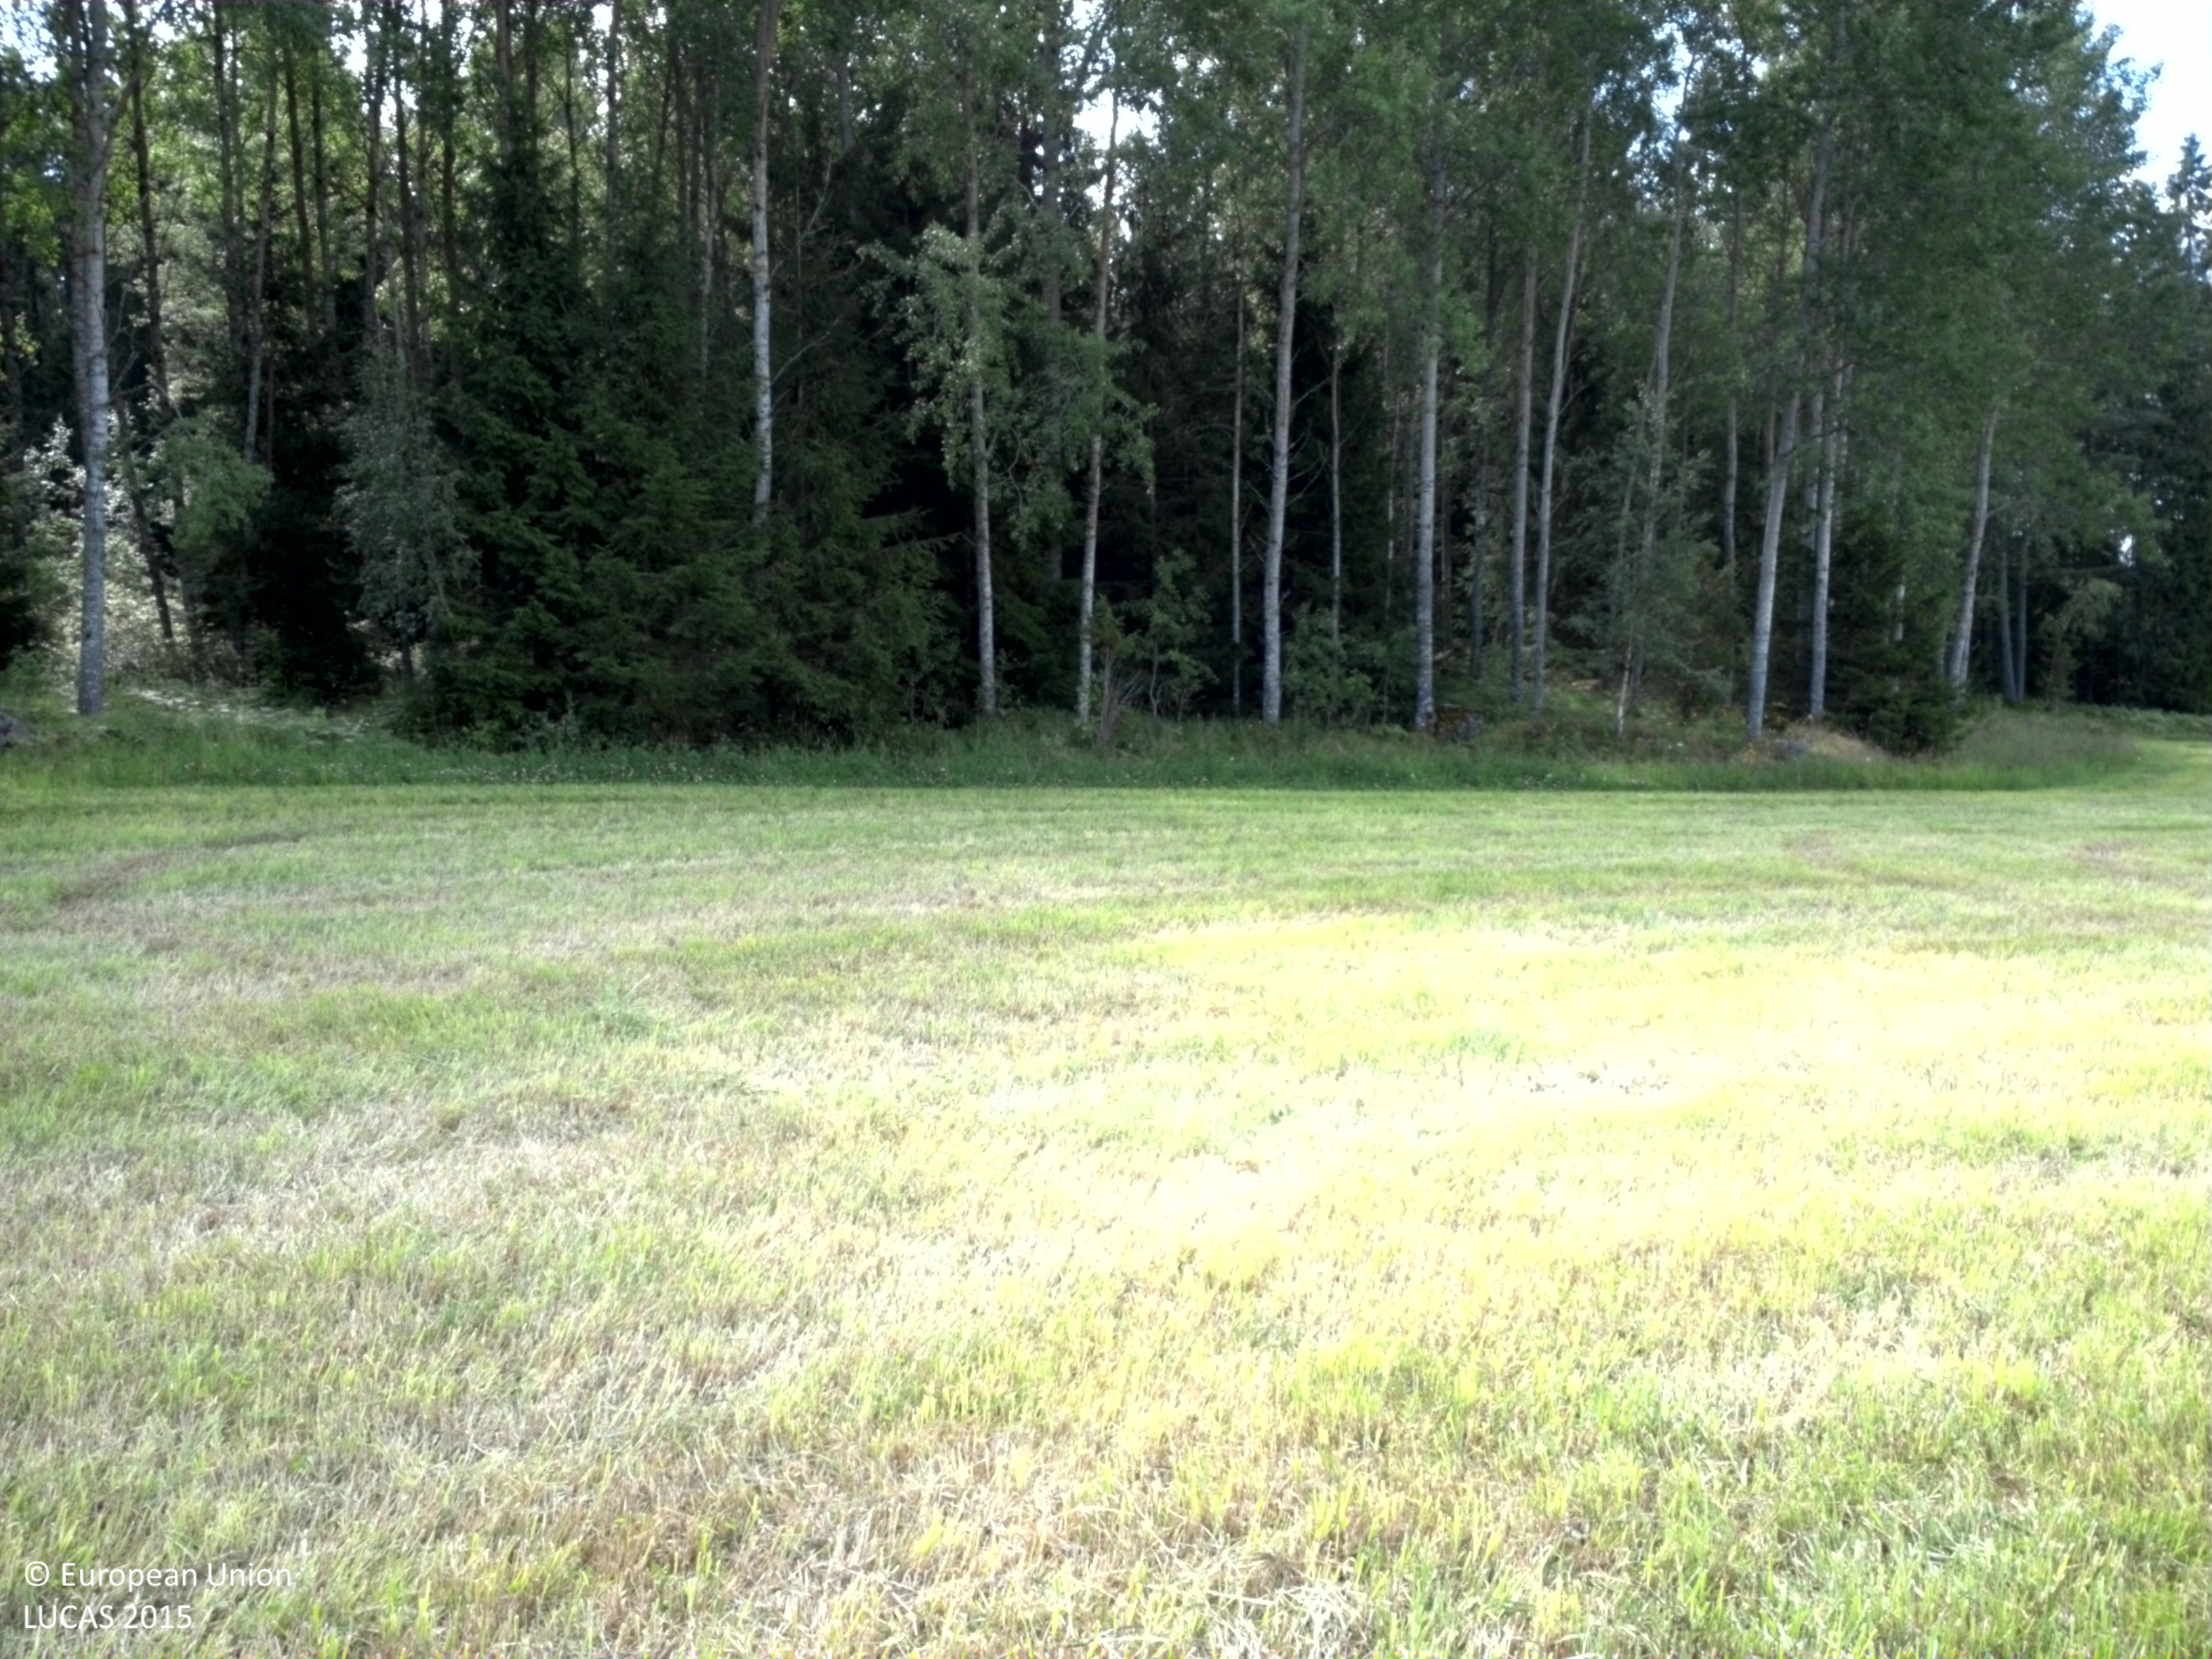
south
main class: Cropland
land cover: Other leguminous and mixtures for fodder
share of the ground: 10 - 25 %
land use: Agriculture (excluding fallow land and kitchen gardens)
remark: Harvested field
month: July
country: SE
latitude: 59.9891
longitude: 18.6199
